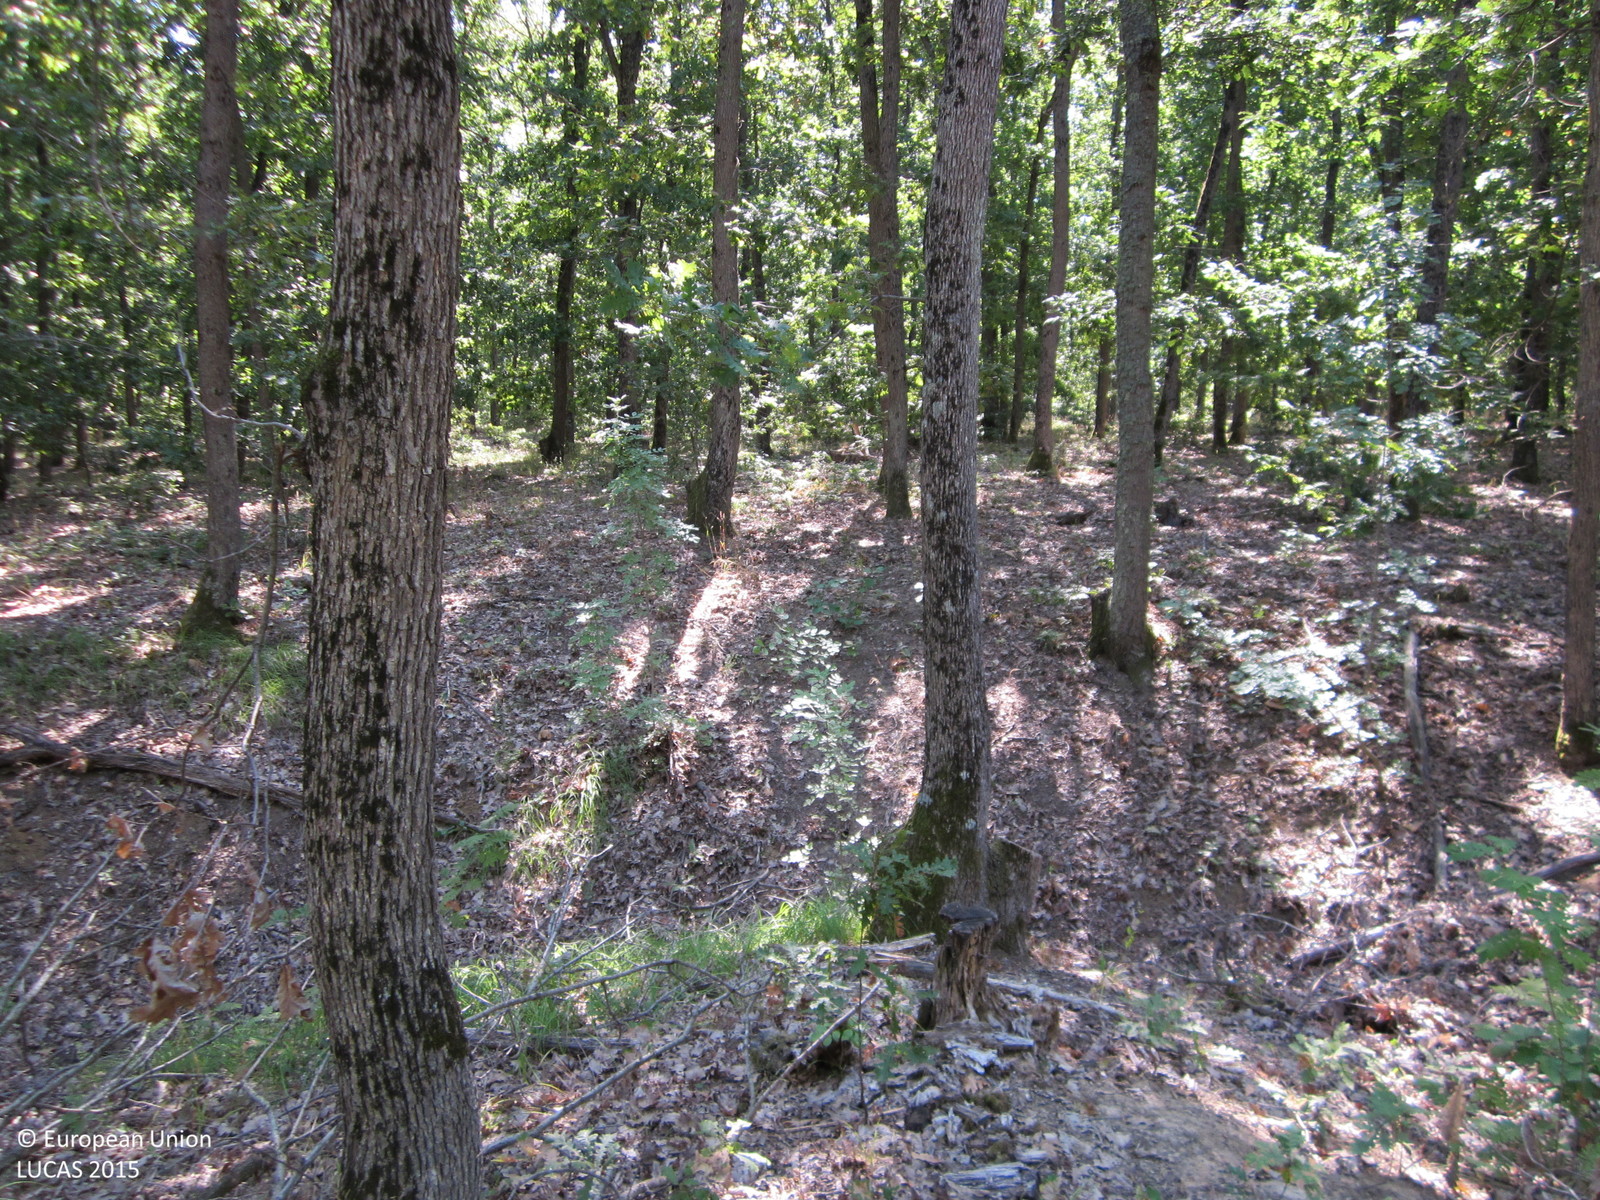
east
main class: Woodland
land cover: Broadleaved woodland
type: thermophilous deciduous forest
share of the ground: > 75 %
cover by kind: broadleaved forest trees 95 %, unconsolidated bare surface 5 %
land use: Forestry
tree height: > 5 m
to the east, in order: Broadleaved woodland; Rivers and streams; Broadleaved woodland; Rivers and streams; Broadleaved woodland
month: August
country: BG
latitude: 42.8709
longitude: 27.7951
